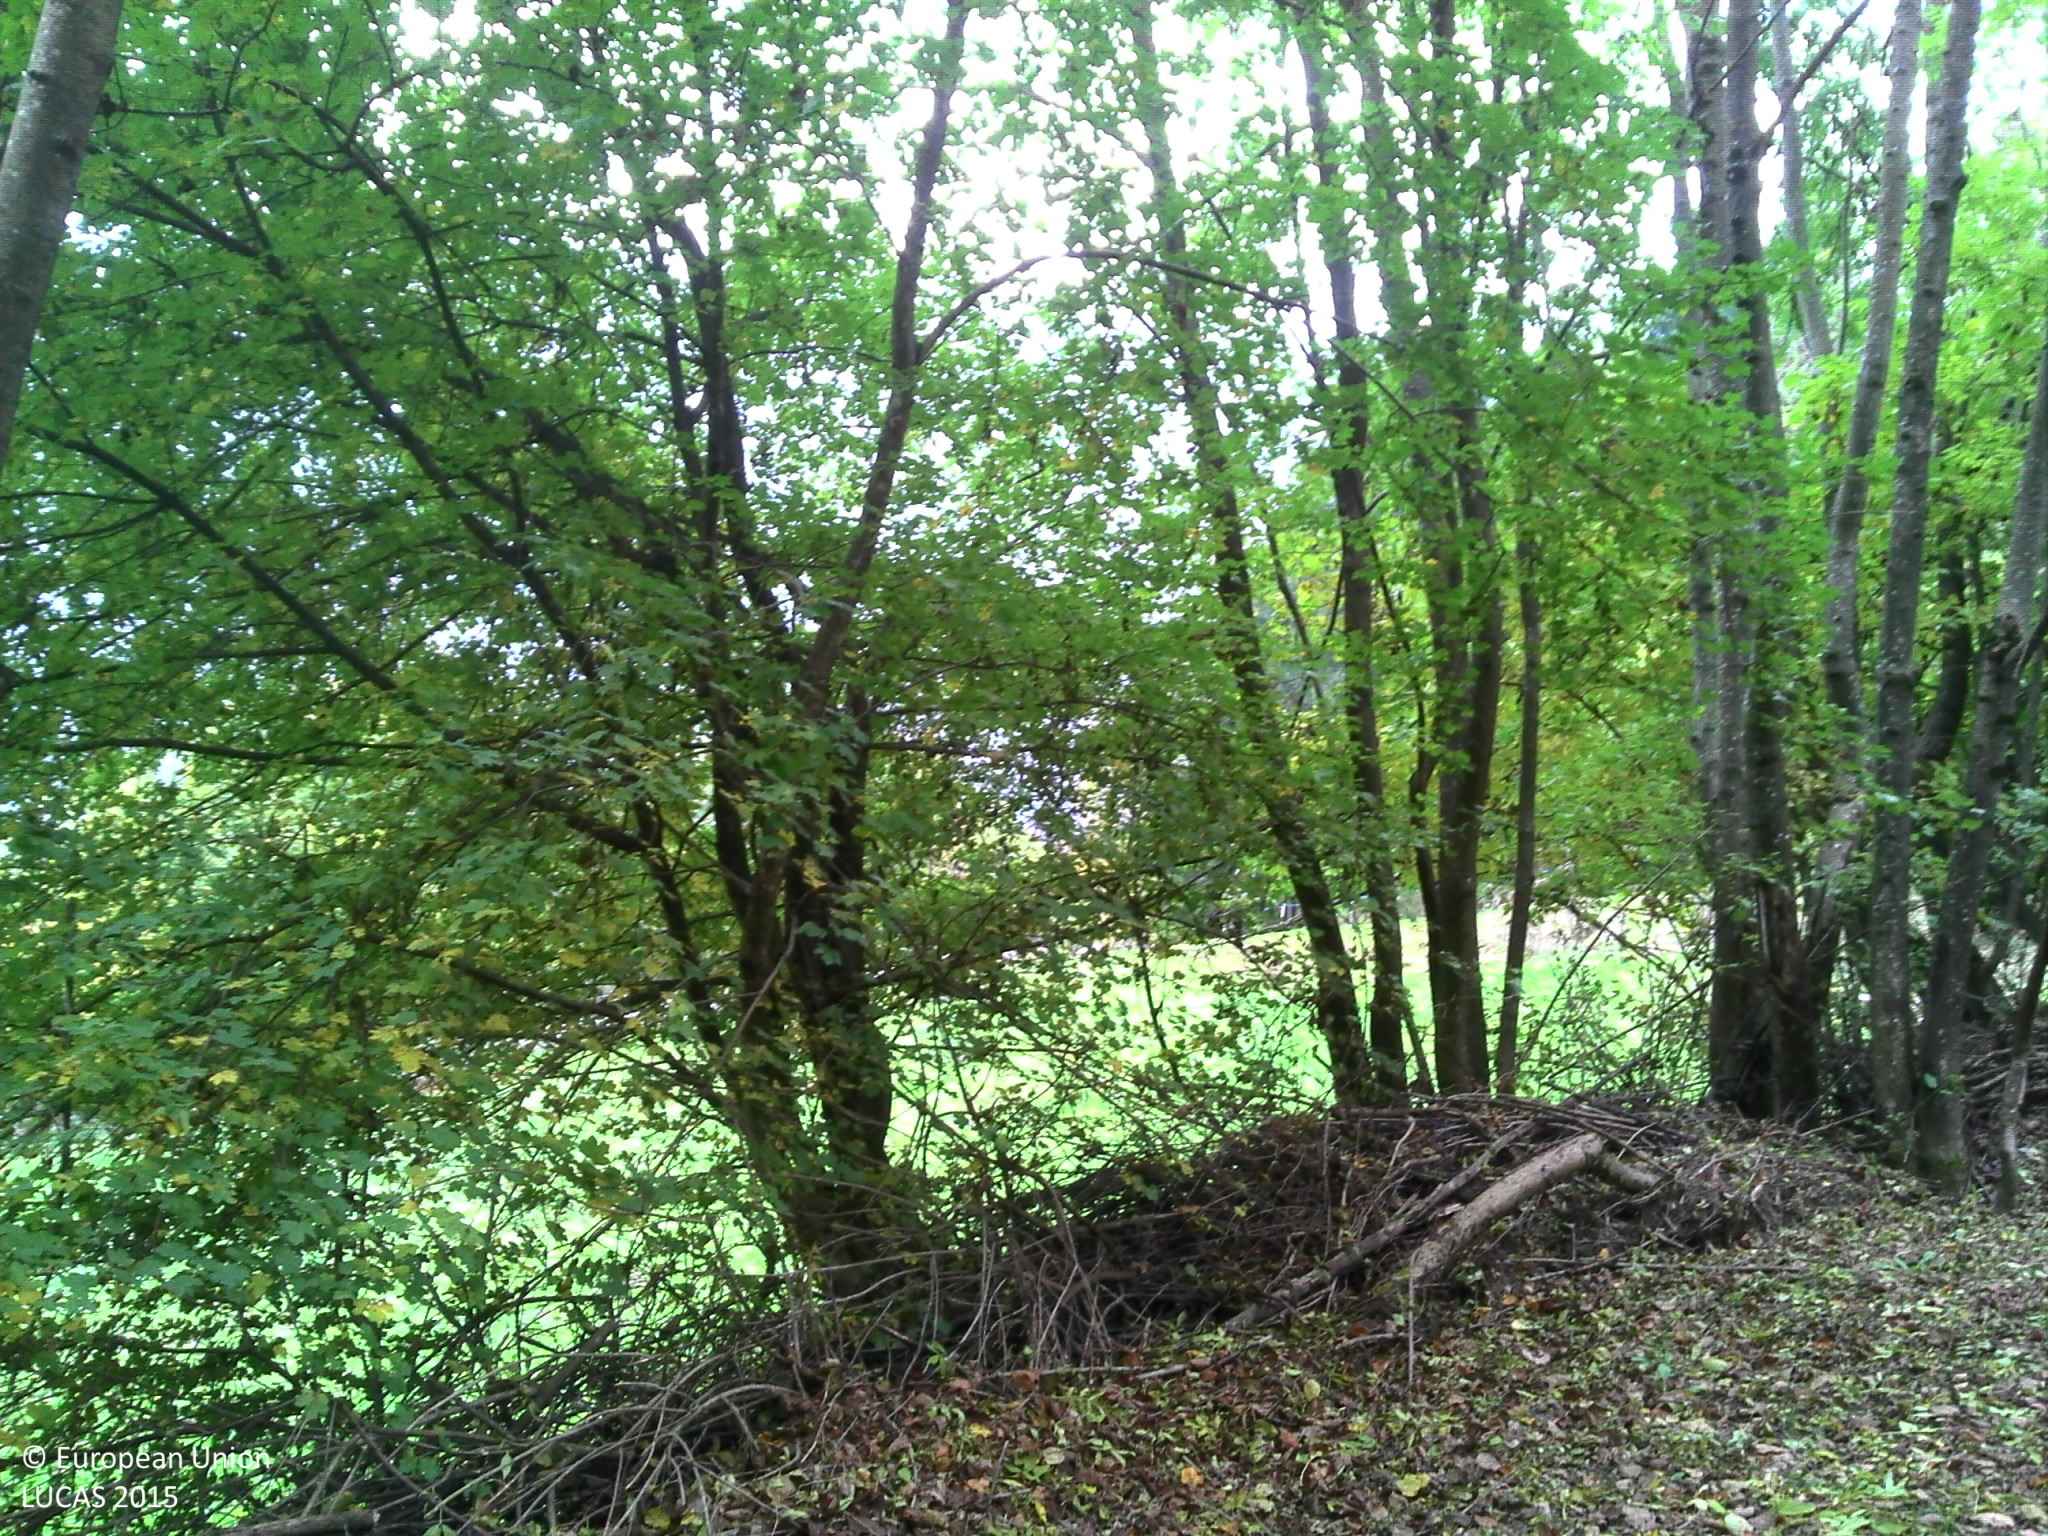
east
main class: Woodland
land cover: Broadleaved woodland
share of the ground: > 75 %
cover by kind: broadleaved forest trees 90 %, unconsolidated bare surface 10 %
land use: Residential
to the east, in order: Broadleaved woodland; Fences; Grassland without tree/shrub cover; Fences; Paved roads, cycling and walking lanes; Grassland without tree/shrub cover; Broadleaved woodland; Artificial constructions in urban areas
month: October
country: FR
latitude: 45.3842
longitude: 6.2628
